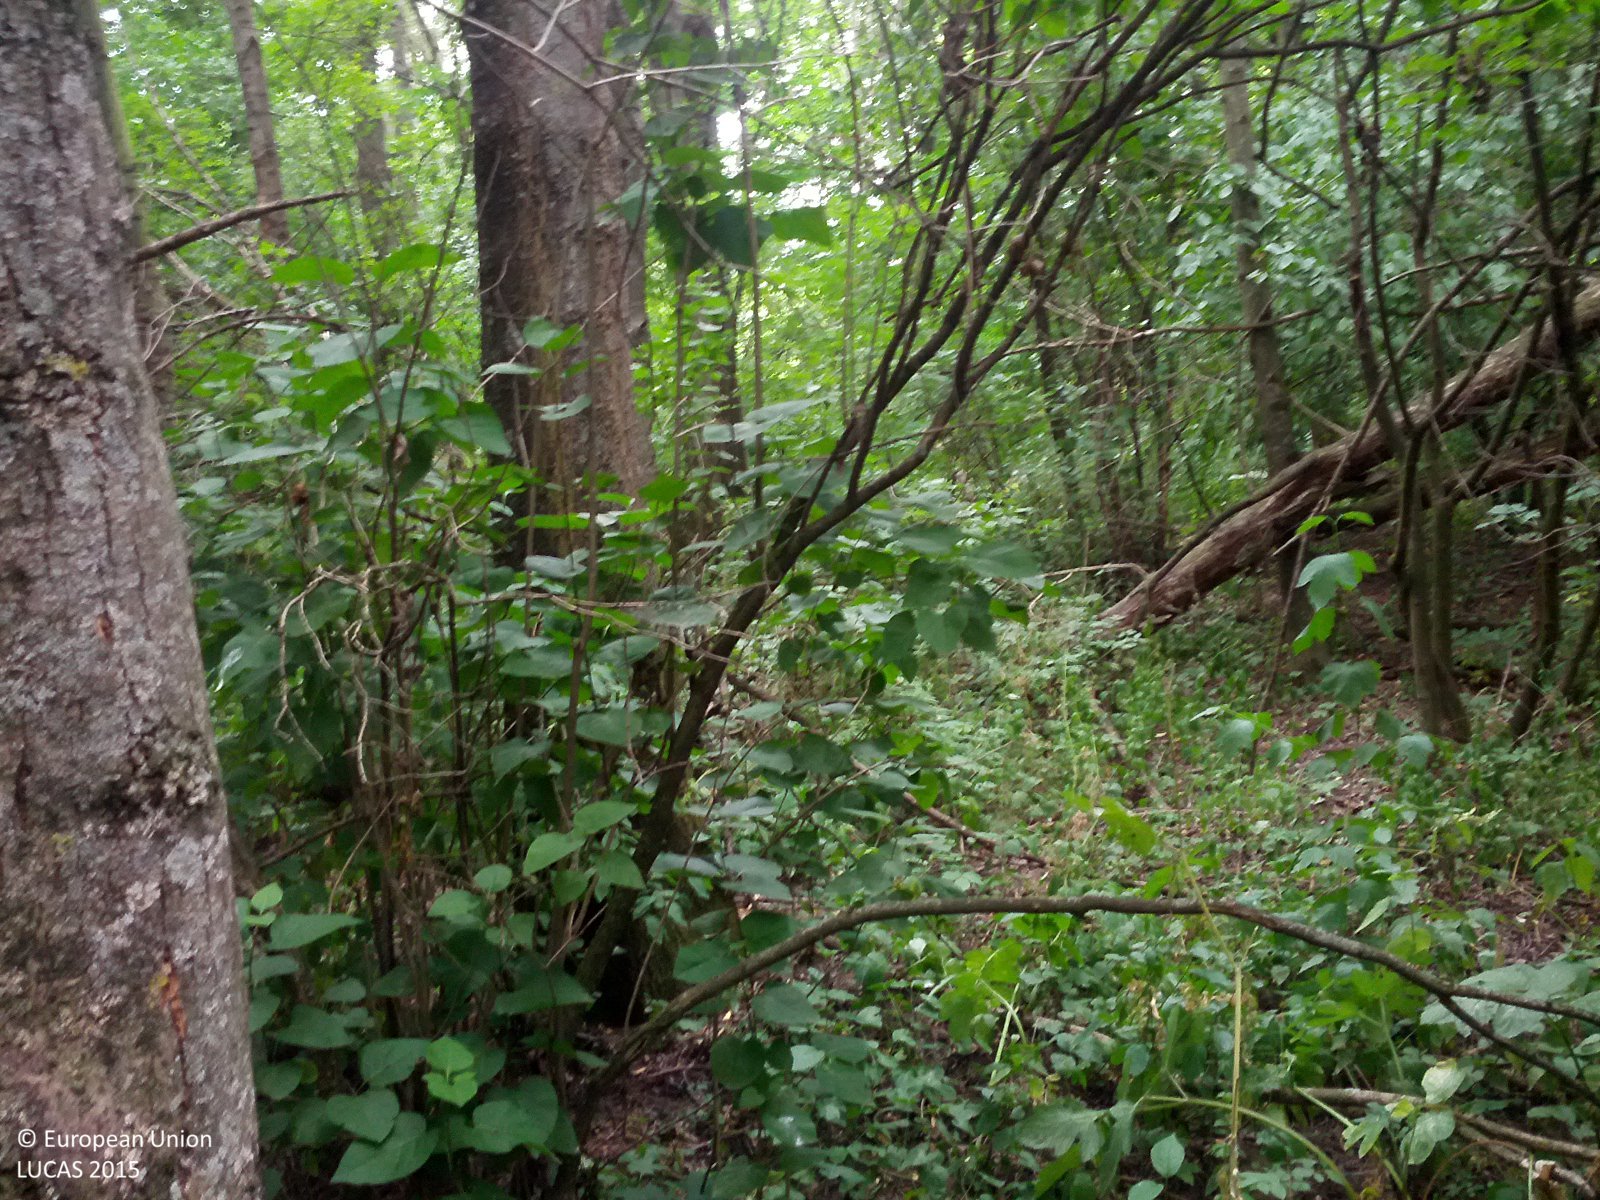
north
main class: Woodland
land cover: Broadleaved woodland
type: floodplain forest
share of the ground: > 75 %
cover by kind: broadleaved forest trees 75 %, shrubs 15 %, herbaceous plants 10 %
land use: Semi-natural and natural areas not in use
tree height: > 5 m
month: July
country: AT
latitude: 48.7655
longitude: 16.6053
